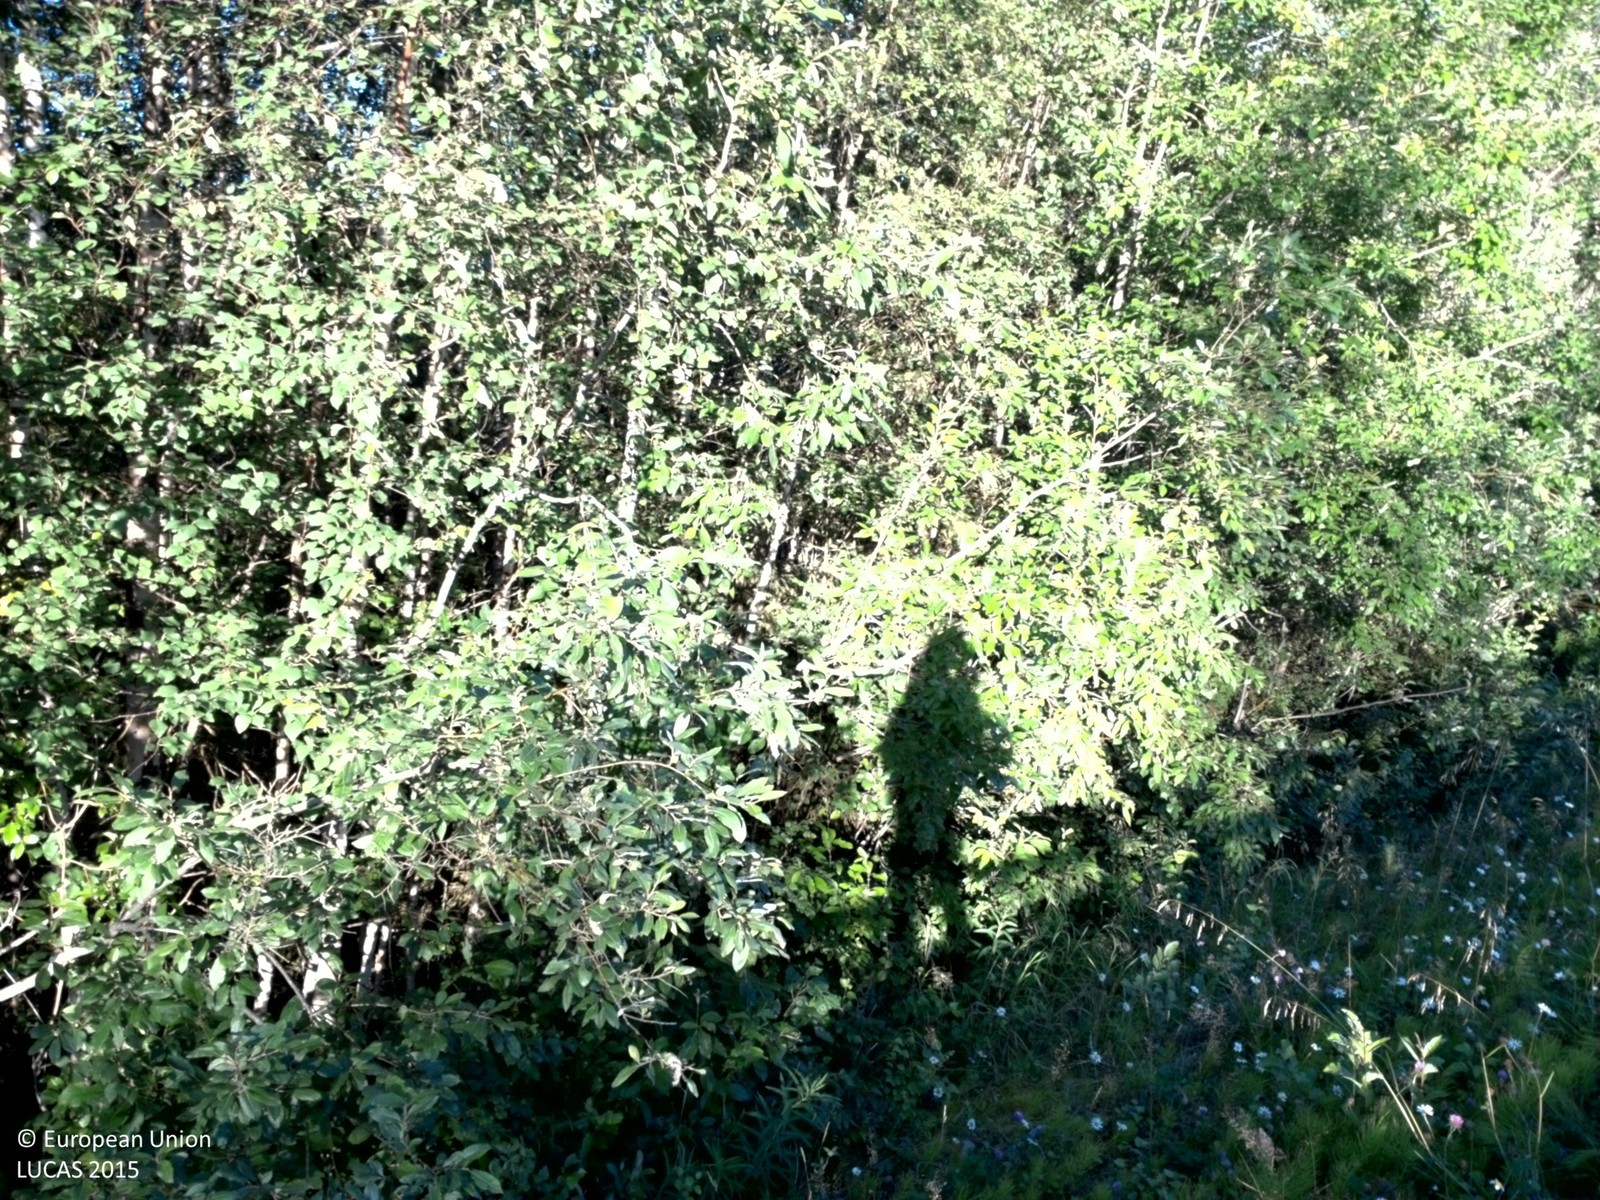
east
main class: Grassland
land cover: Grassland without tree/shrub cover
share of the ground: > 75 %
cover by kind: herbaceous plants 100 %
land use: Road transport
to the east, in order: Grassland without tree/shrub cover; Broadleaved woodland; Spruce dominated mixed woodland; Inland fresh running water; Spruce dominated mixed woodland; Inland fresh running water; Spruce dominated mixed woodland
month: August
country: SE
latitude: 66.3740
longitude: 20.7145
